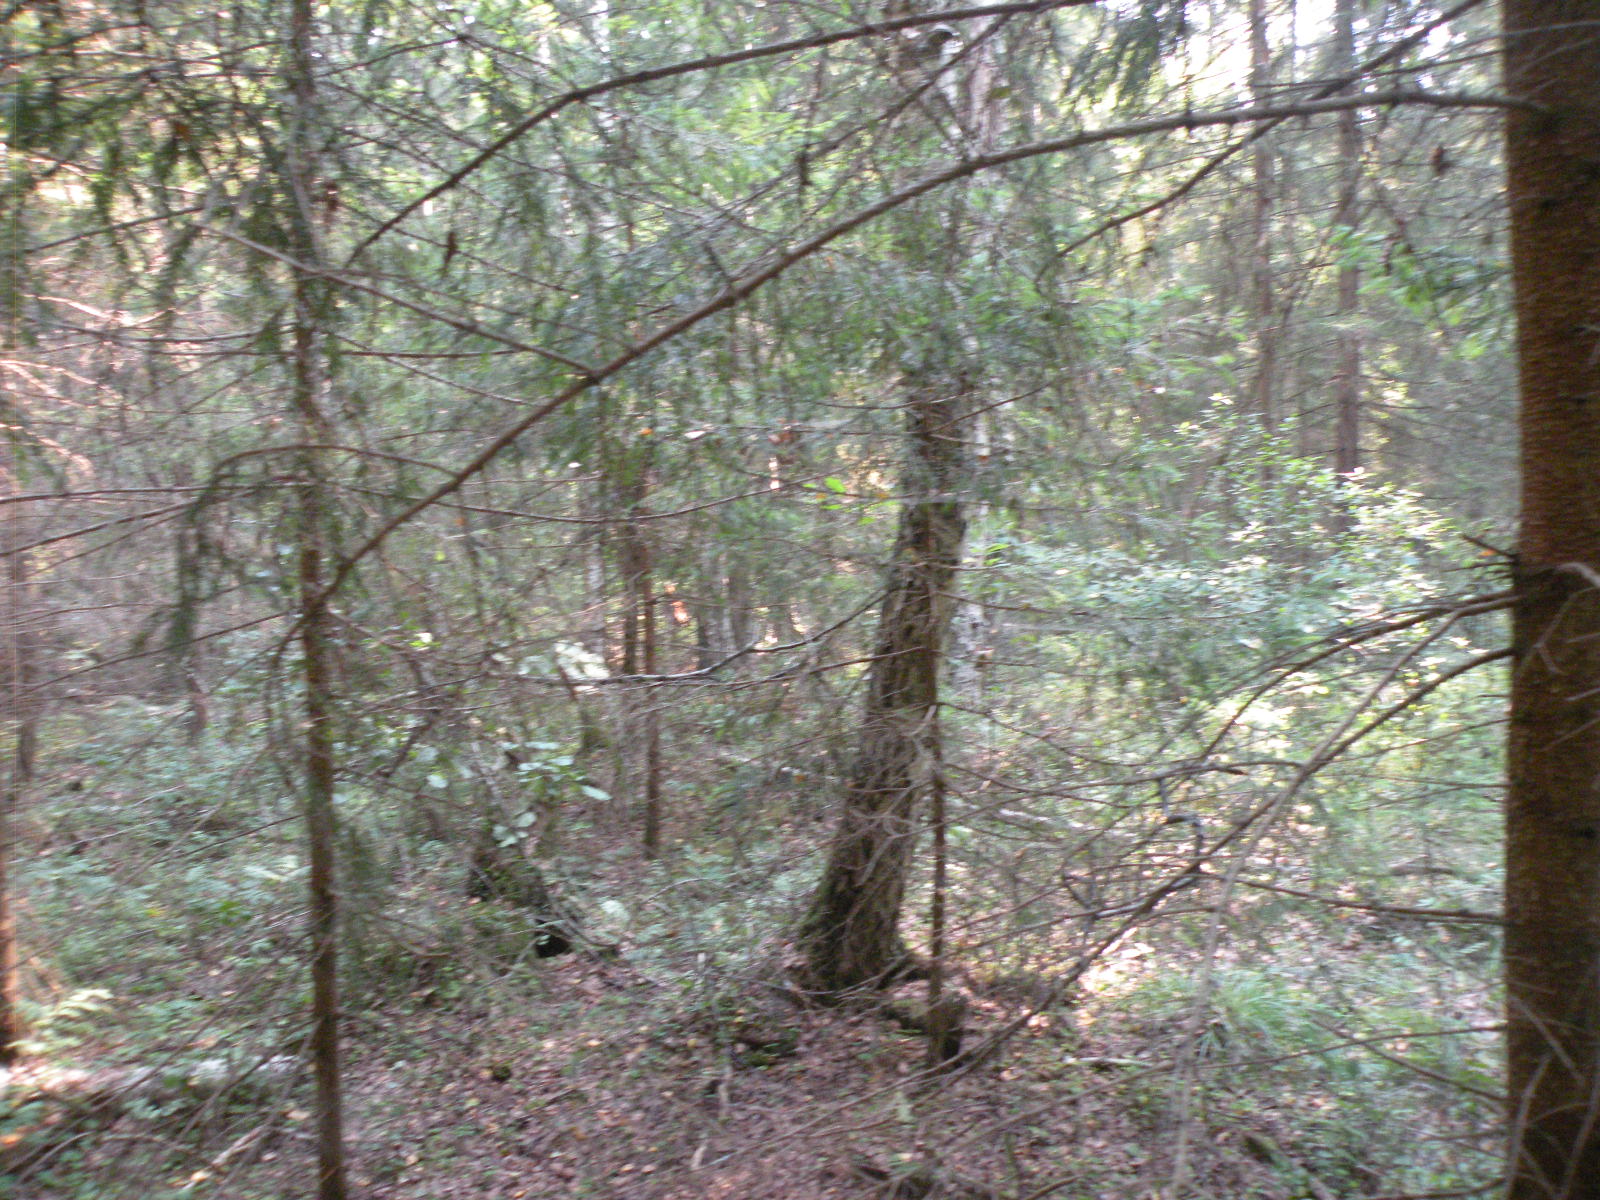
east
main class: Woodland
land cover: Spruce dominated mixed woodland
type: hemiboreal forest and nemoral coniferous forest and mixed broadleaved-coniferous forest
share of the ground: > 75 %
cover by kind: coniferous forest trees 60 %, broadleaved forest trees 25 %, herbaceous plants 5 %, lichens and mosses 5 %, unconsolidated bare surface 5 %
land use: Forestry
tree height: > 5 m
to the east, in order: Spruce dominated mixed woodland; Spruce dominated coniferous woodland; Ditches and canals; Spruce dominated coniferous woodland
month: August
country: LV
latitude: 55.7647
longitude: 26.6843
